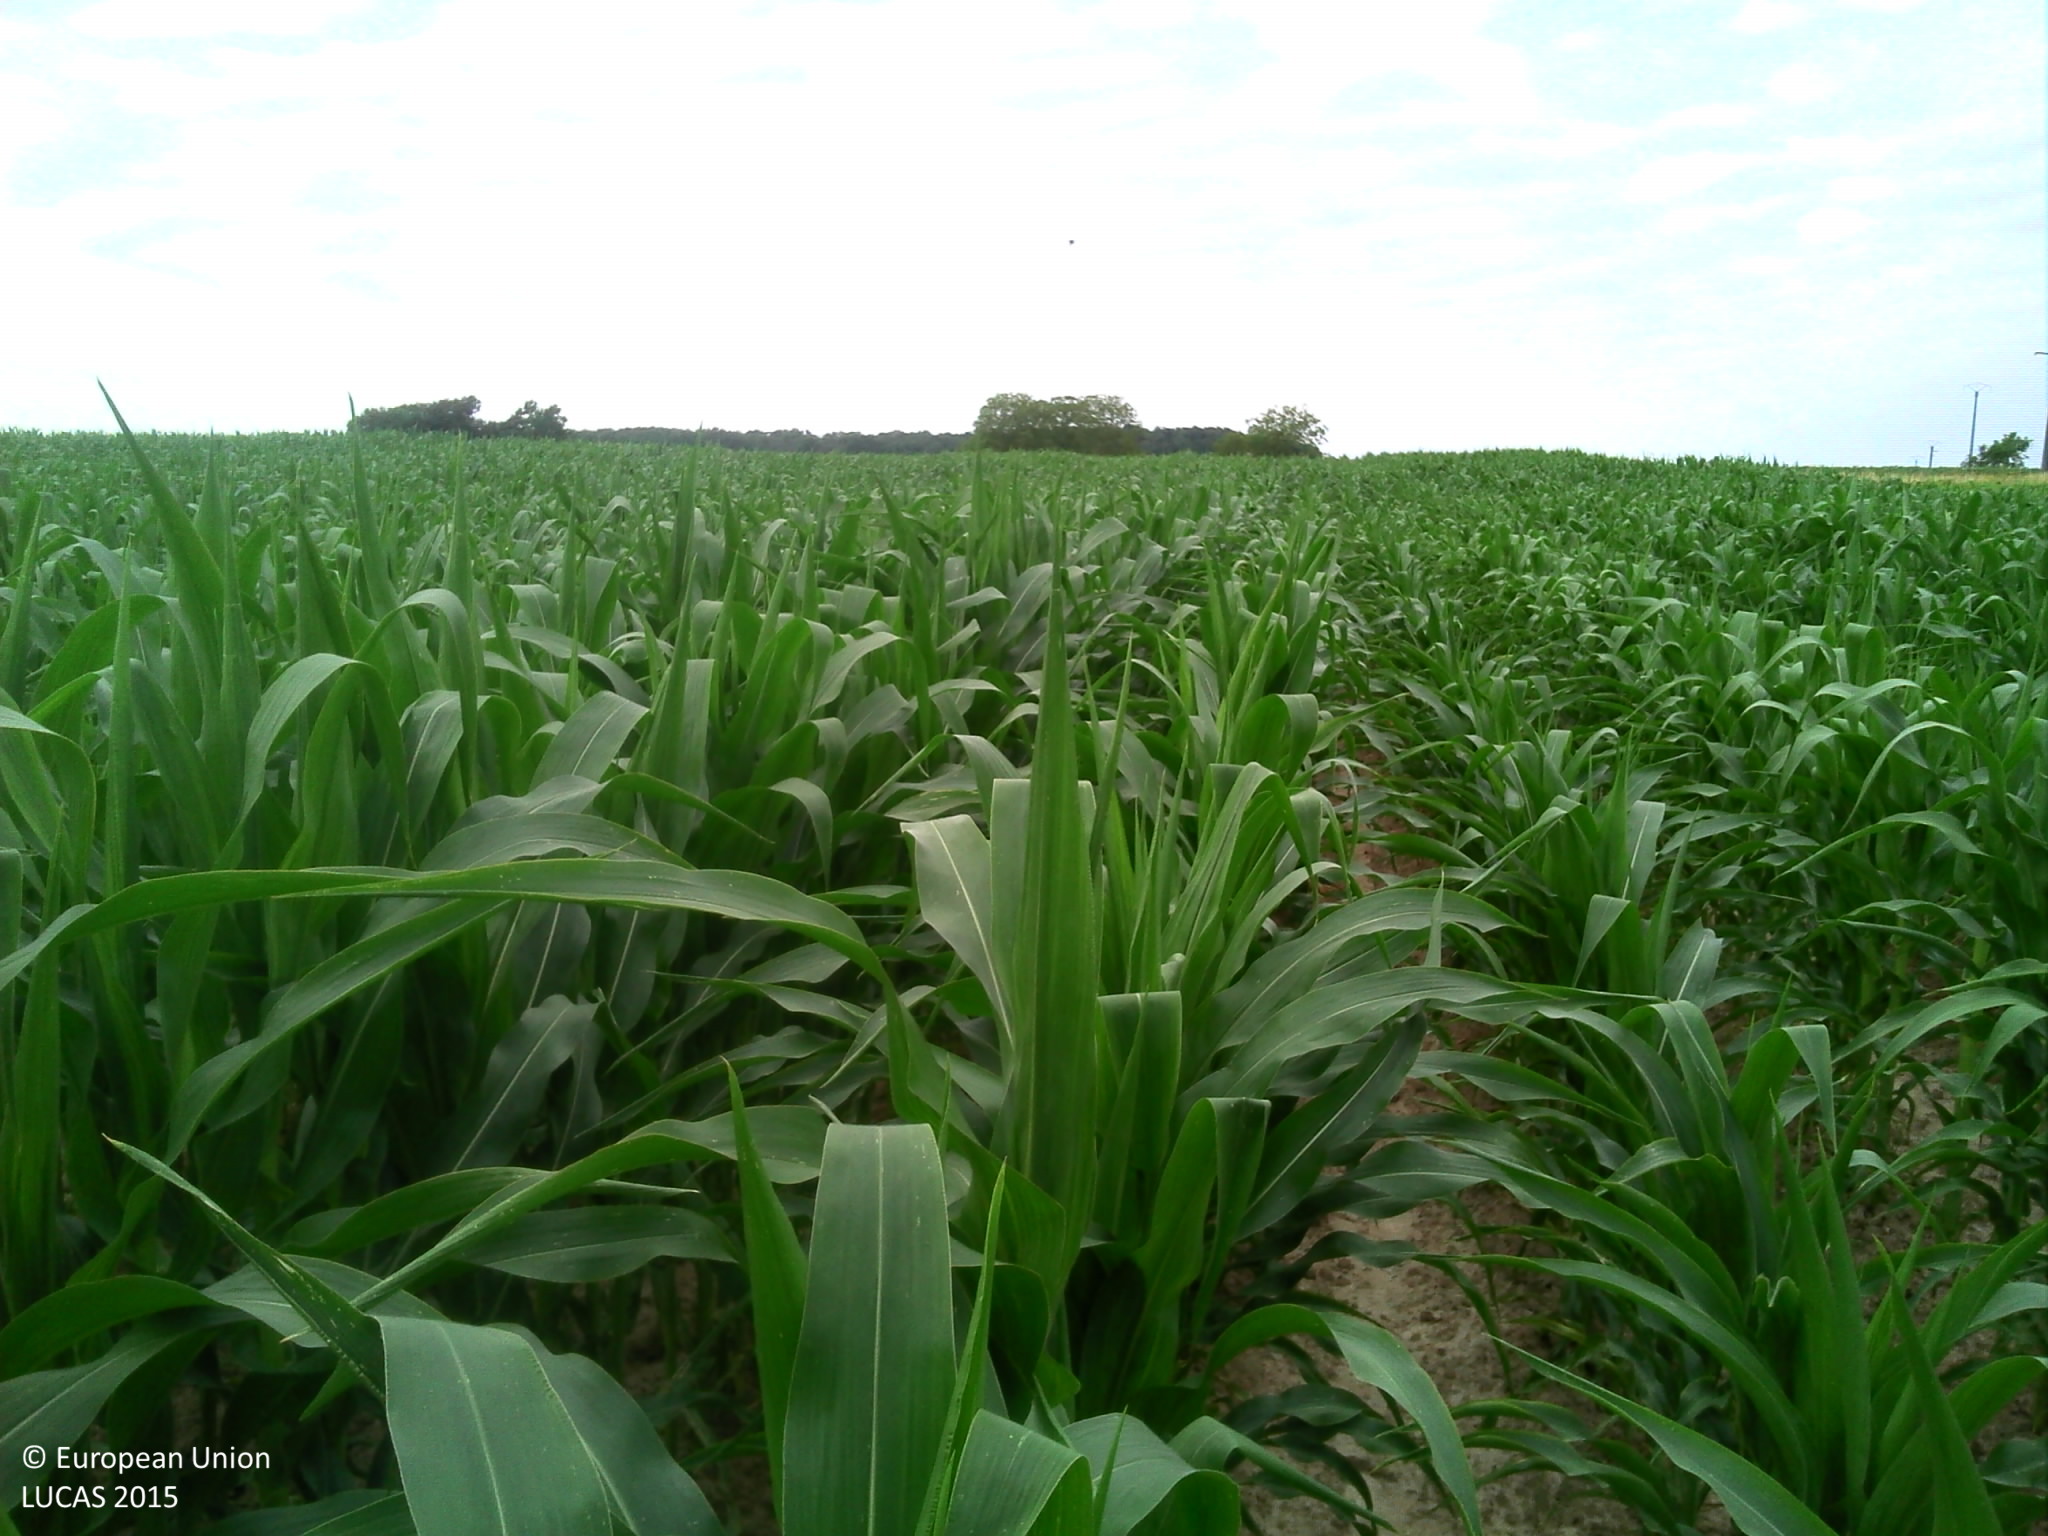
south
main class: Cropland
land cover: Maize
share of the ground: > 75 %
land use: Agriculture (excluding fallow land and kitchen gardens)
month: July
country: FR
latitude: 45.4243
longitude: -0.5915
